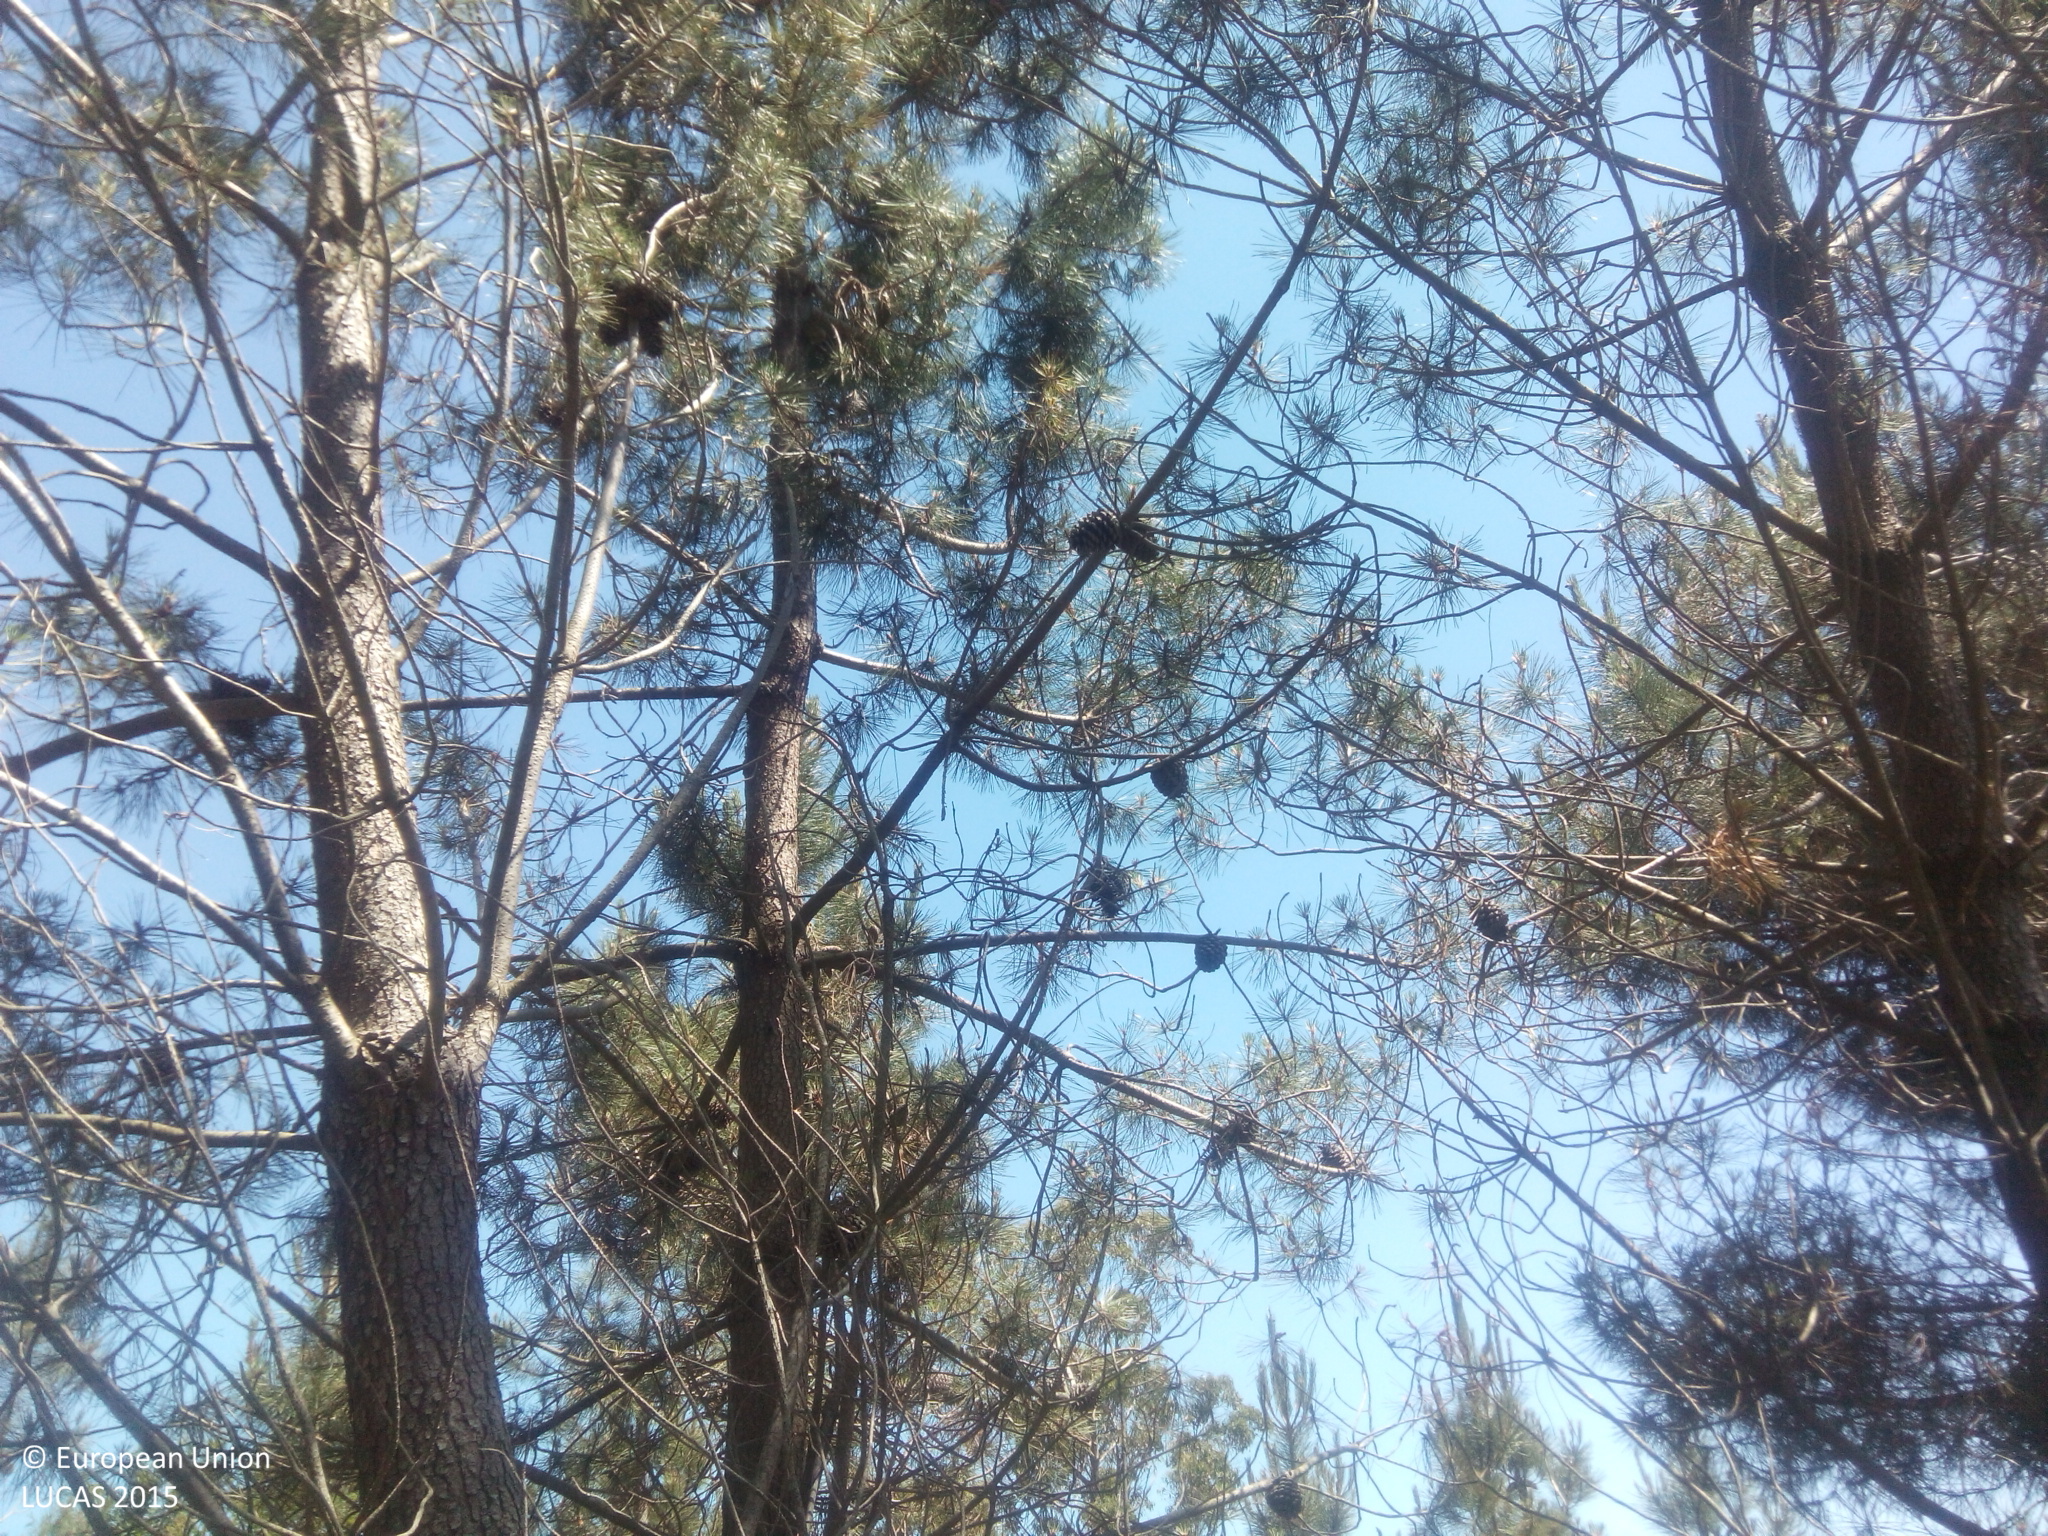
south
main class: Woodland
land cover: Pine dominated coniferous woodland
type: hemiboreal forest and nemoral coniferous forest and mixed broadleaved-coniferous forest
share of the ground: > 75 %
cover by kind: coniferous forest trees 60 %, shrubs 25 %, herbaceous plants 15 %
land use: Forestry
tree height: > 5 m
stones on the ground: < 10 %
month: June
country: ES
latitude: 42.4663
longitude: -8.2980
